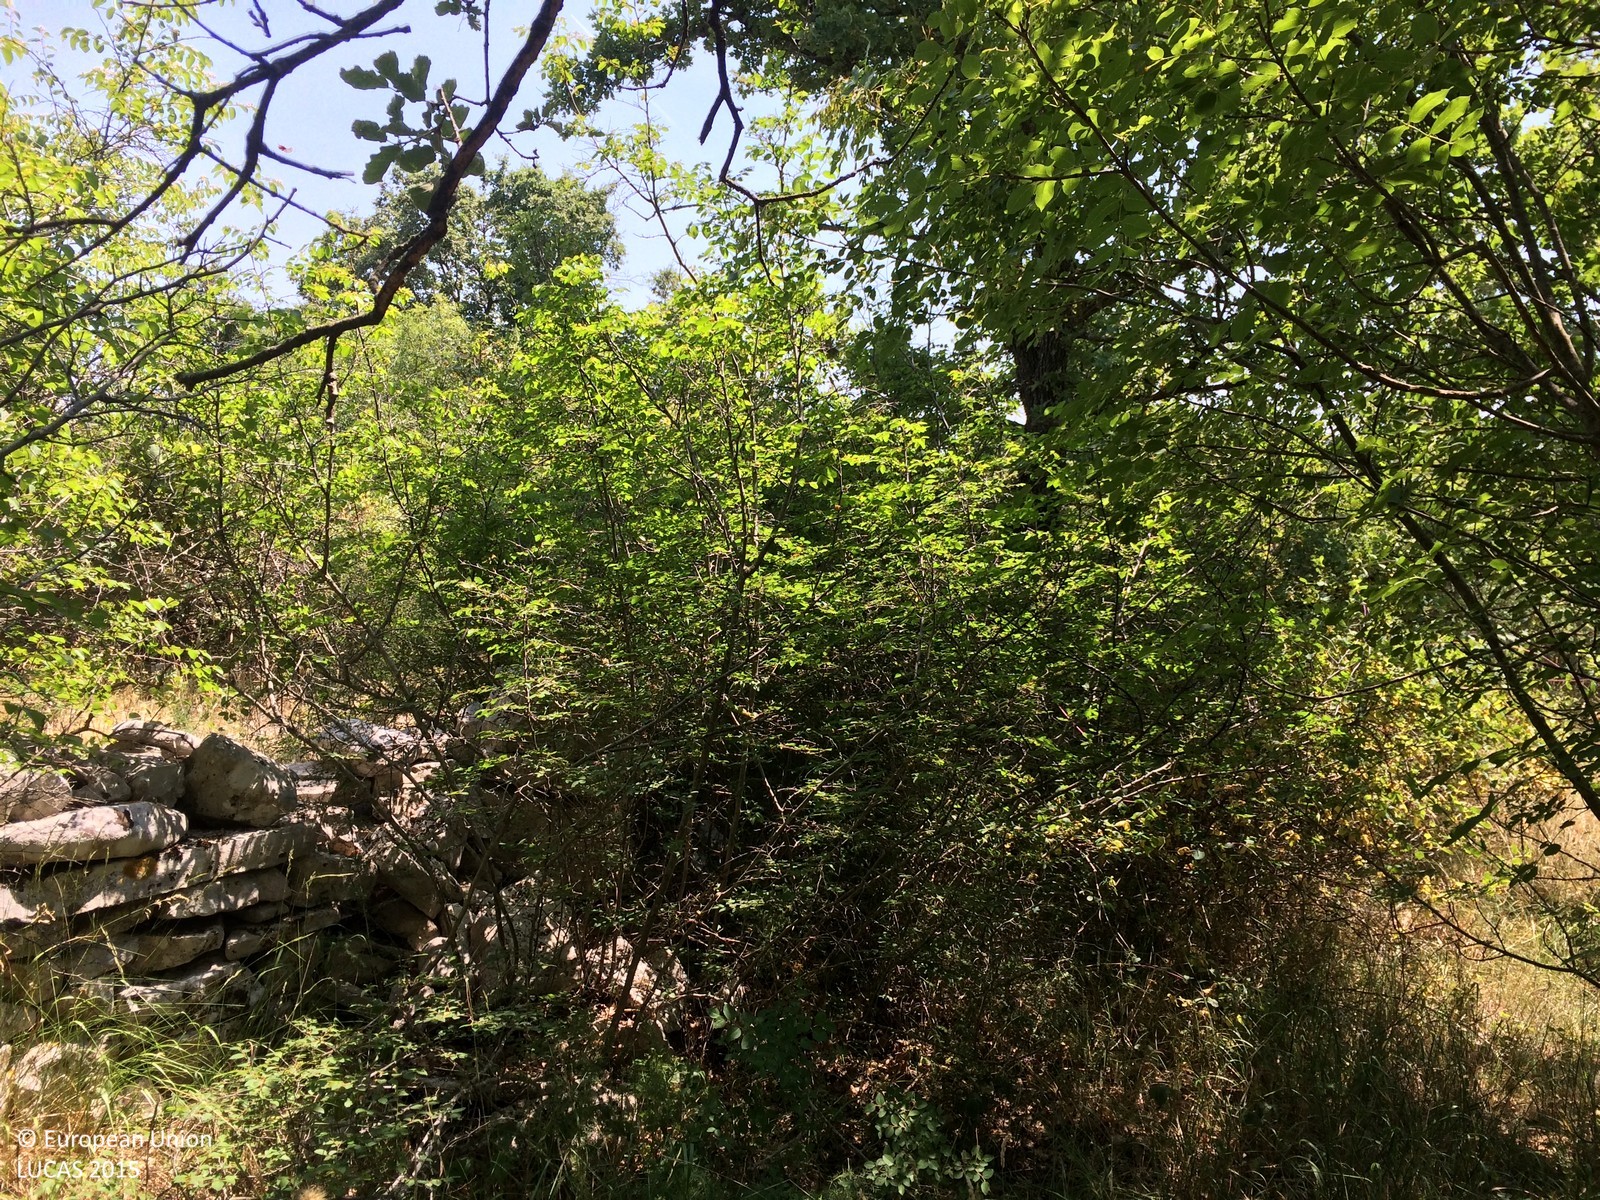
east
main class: Grassland
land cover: Grassland with sparse tree/shrub cover
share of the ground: 50 - 75 %
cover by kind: herbaceous plants 90 %, broadleaved forest trees 5 %, shrubs 5 %
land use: Semi-natural and natural areas not in use
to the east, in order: Grassland with sparse tree/shrub cover; Dry stone walls; Tracks; Dry stone walls; Shrubland with sparse tree cover; Rocks and stones; Tracks; Grassland with sparse tree/shrub cover; Dry stone walls; Grassland with sparse tree/shrub cover; Dry stone walls; Grassland without tree/shrub cover; Shrubland with sparse tree cover; Dry stone walls; Grassland with sparse tree/shrub cover; Dry stone walls; Grassland with sparse tree/shrub cover
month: June
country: HR
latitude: 45.0367
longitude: 13.8661
